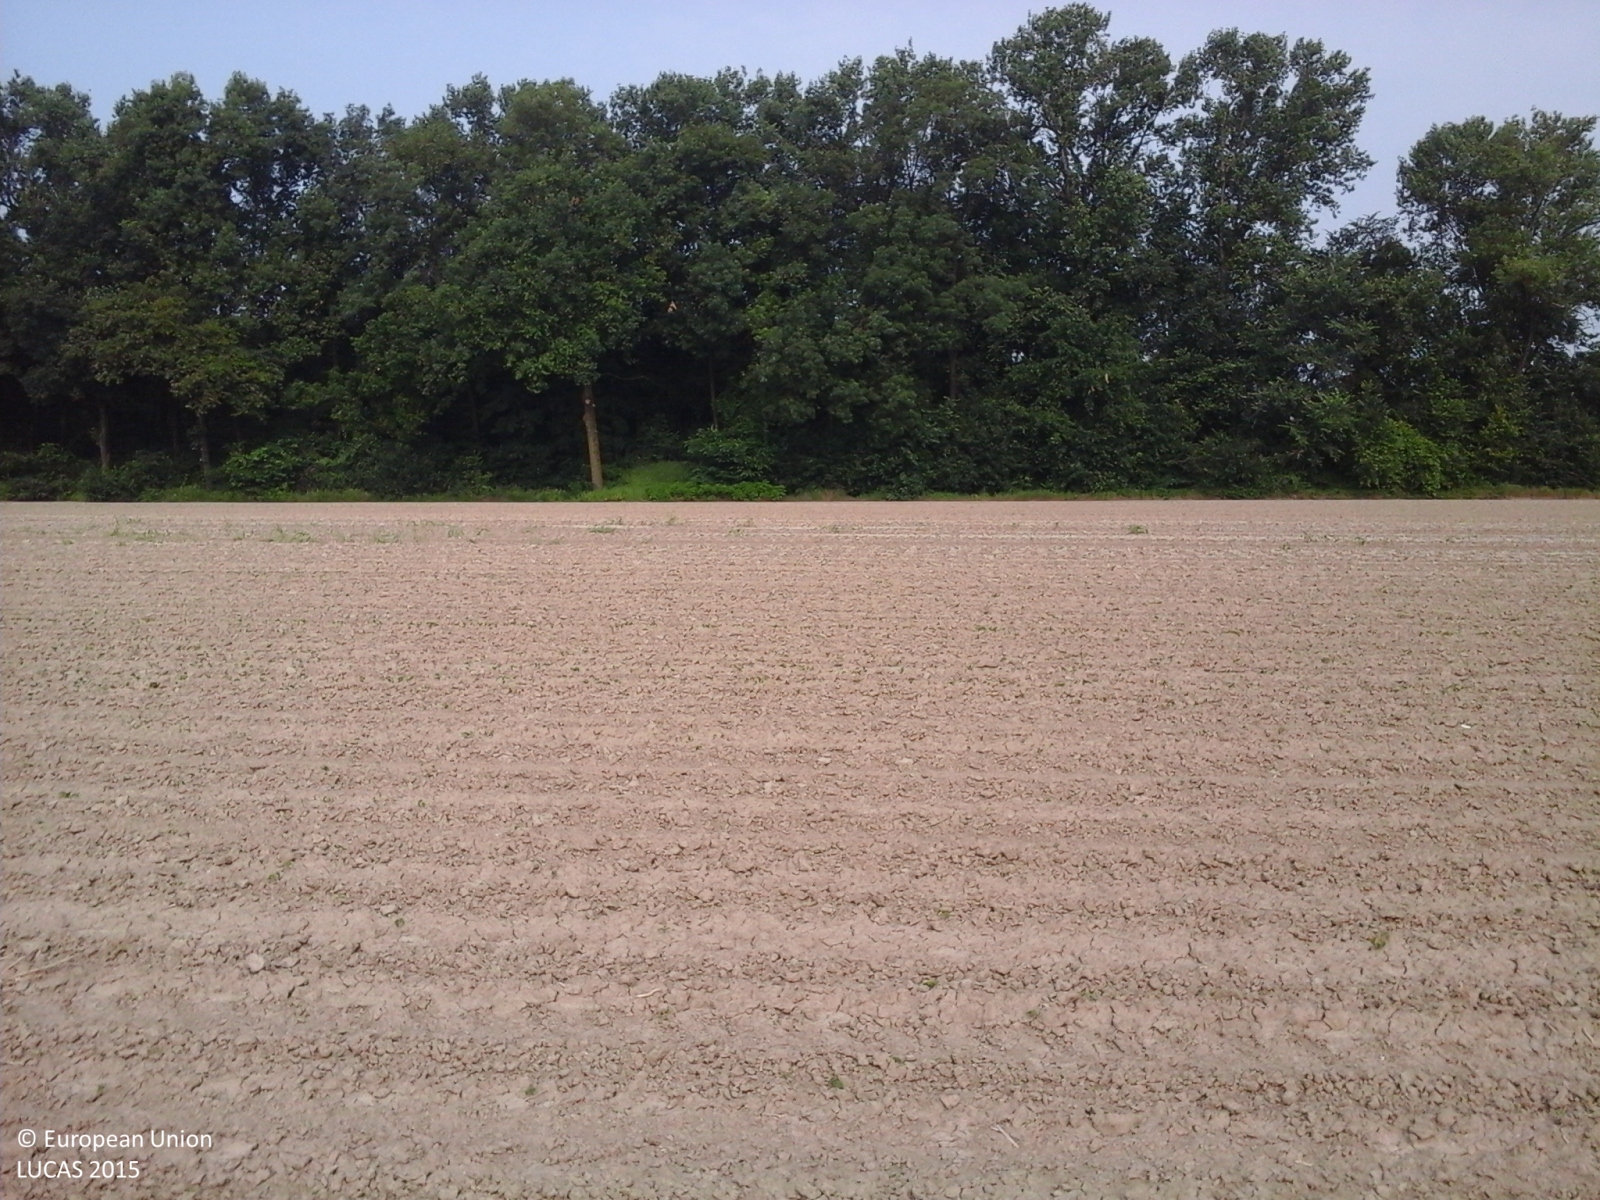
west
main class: Cropland
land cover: Maize
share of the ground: < 10 %
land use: Agriculture (excluding fallow land and kitchen gardens)
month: June
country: IT
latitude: 45.0538
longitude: 10.0127
